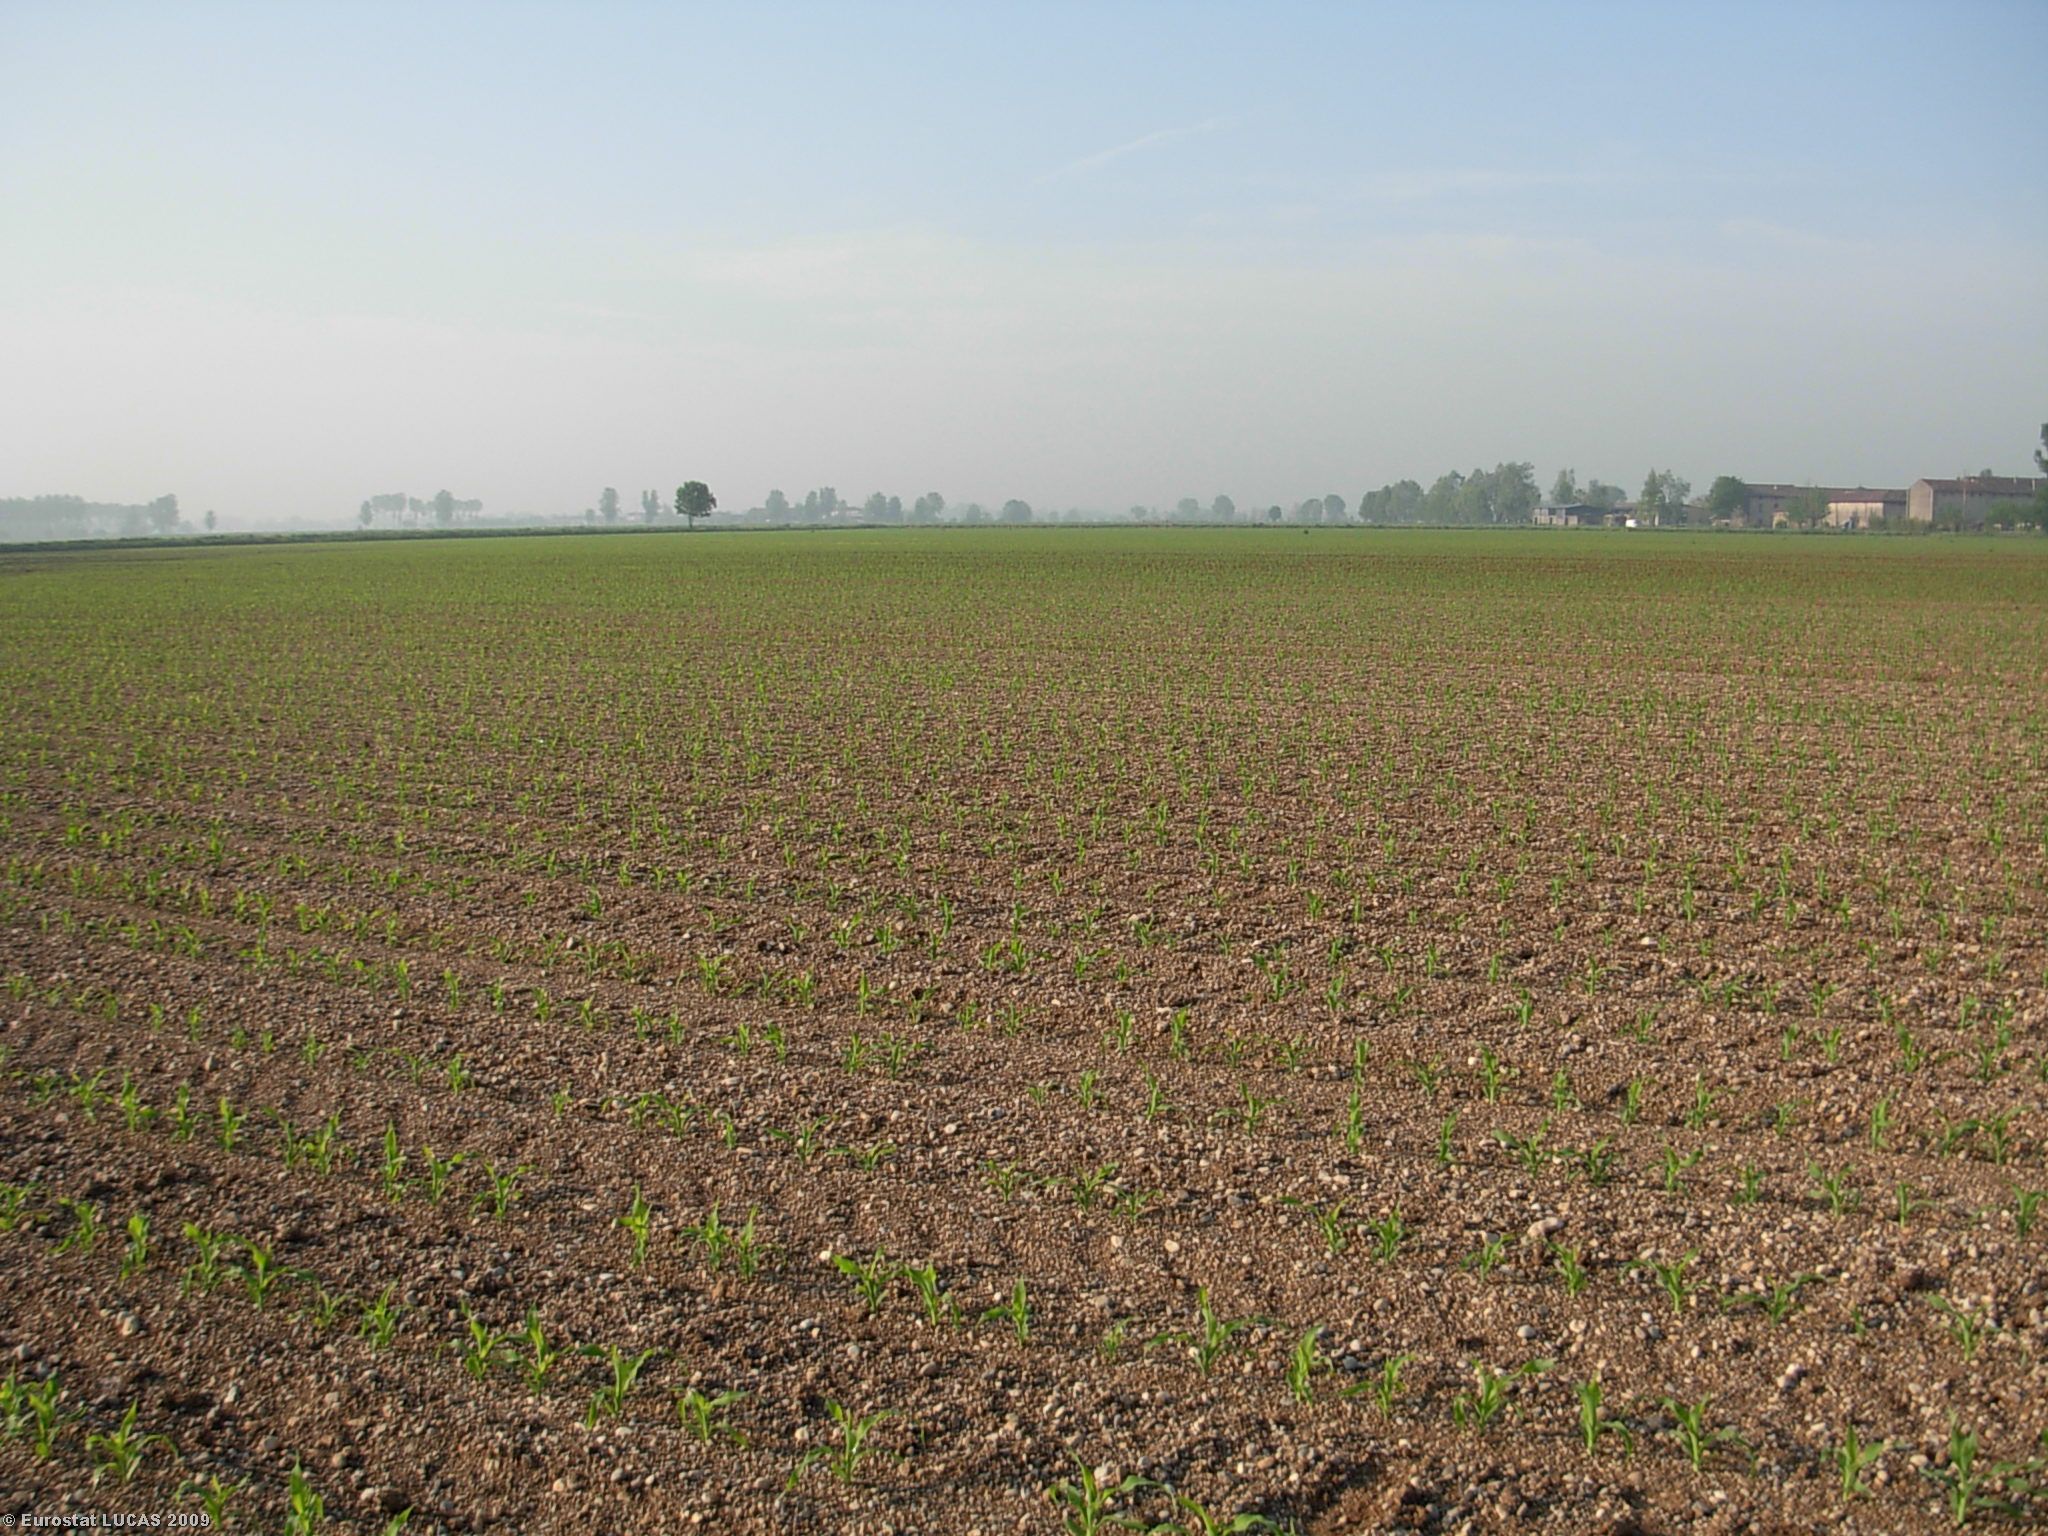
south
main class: Cropland
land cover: Maize
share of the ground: < 10 %
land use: Agriculture (excluding fallow land and kitchen gardens)
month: May
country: IT
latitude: 45.2695
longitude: 10.3435
